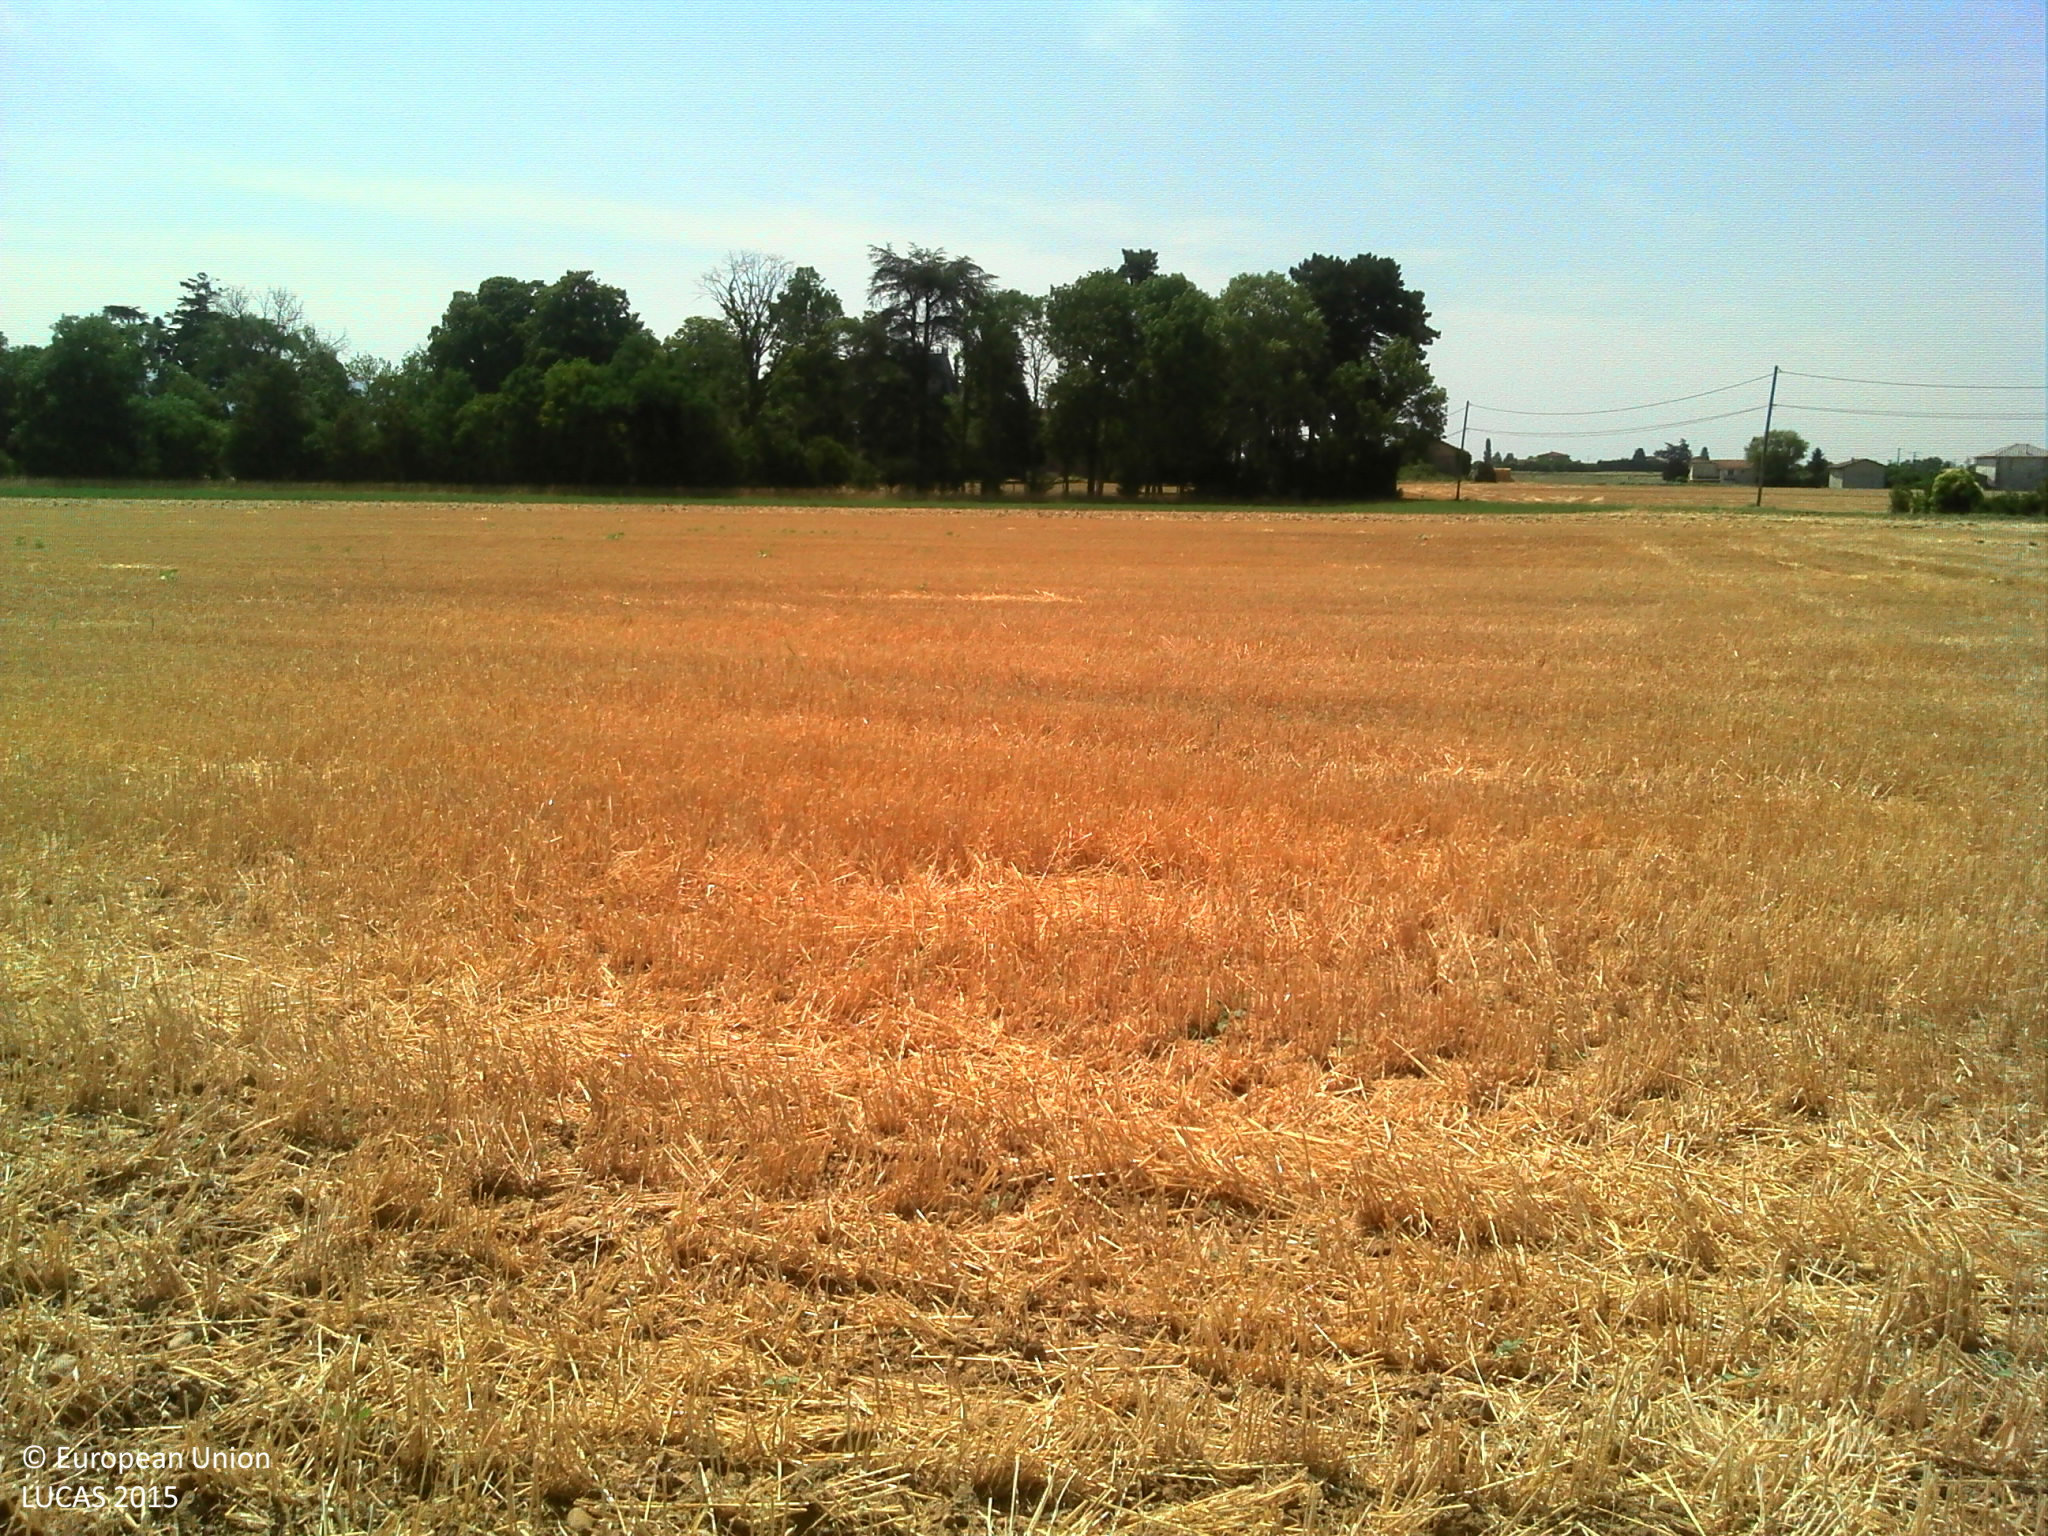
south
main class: Cropland
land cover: Barley
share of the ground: > 75 %
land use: Agriculture (excluding fallow land and kitchen gardens)
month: July
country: FR
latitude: 44.9897
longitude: 5.0210
